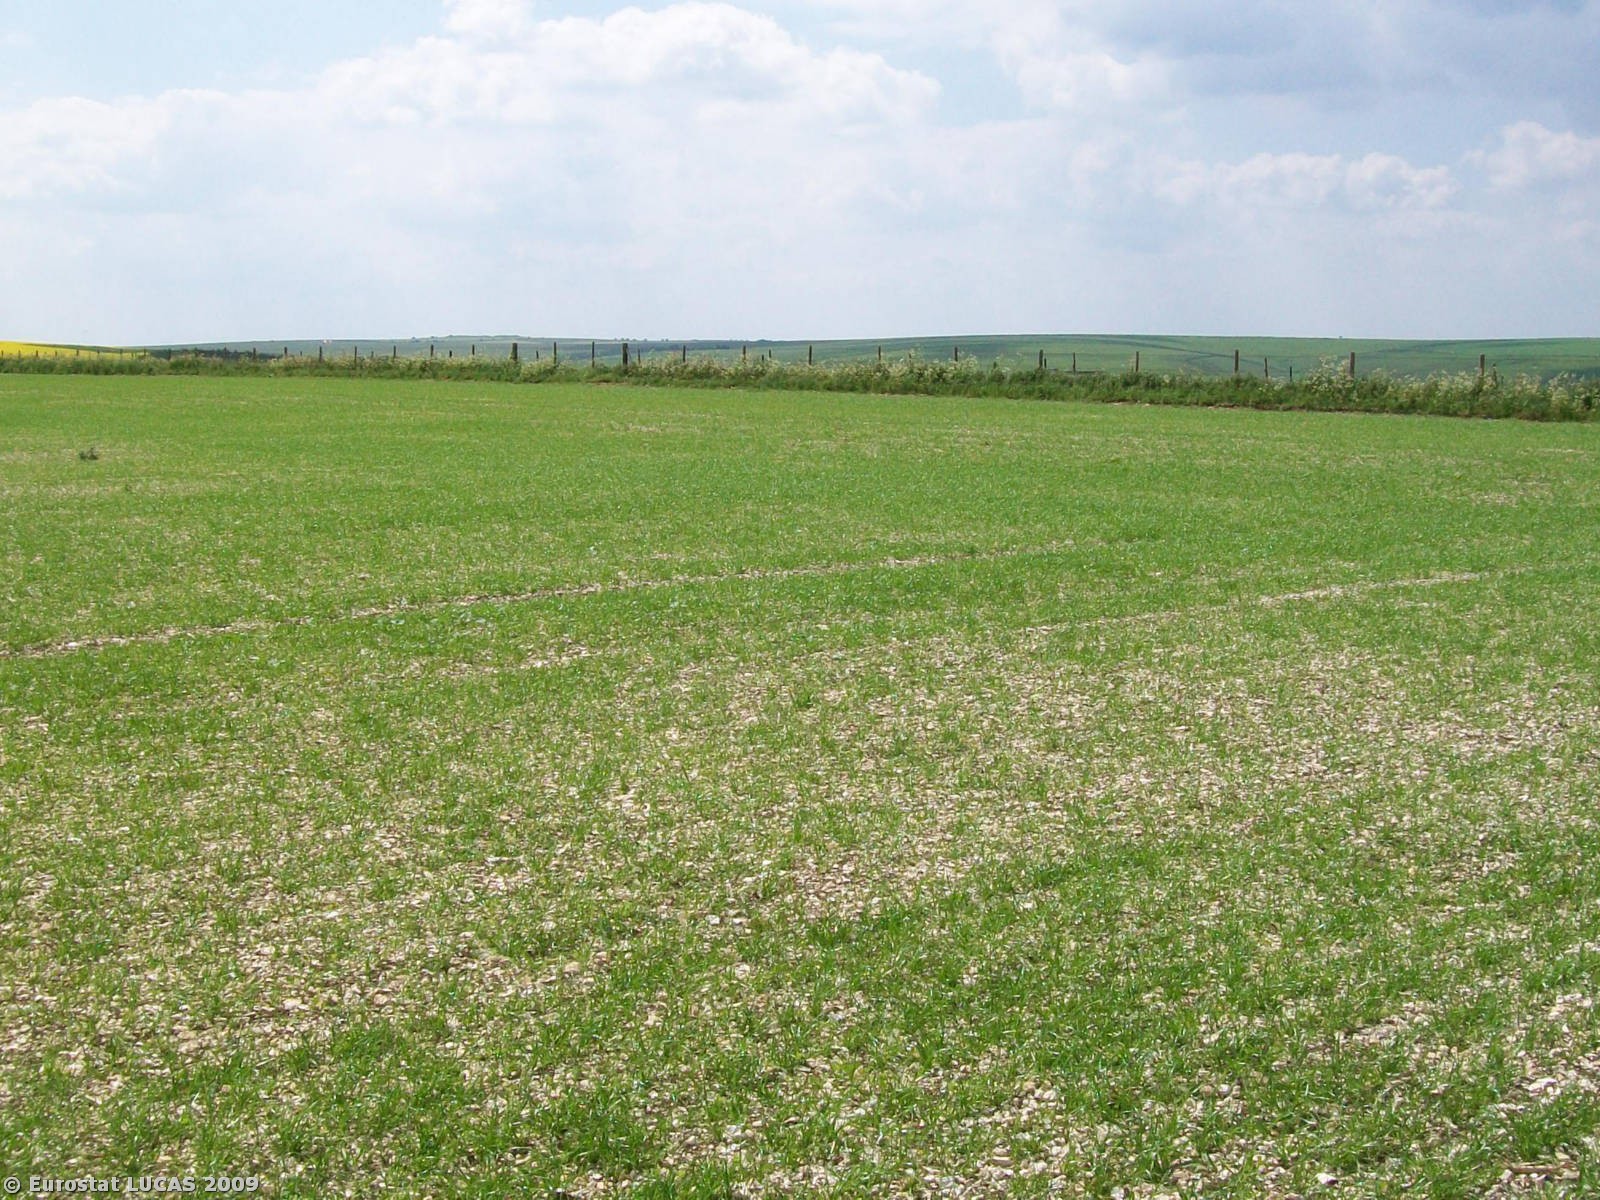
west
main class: Cropland
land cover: Barley
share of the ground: 50 - 75 %
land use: Agriculture (excluding fallow land and kitchen gardens)
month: May
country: GB
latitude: 51.1246
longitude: -2.2210
